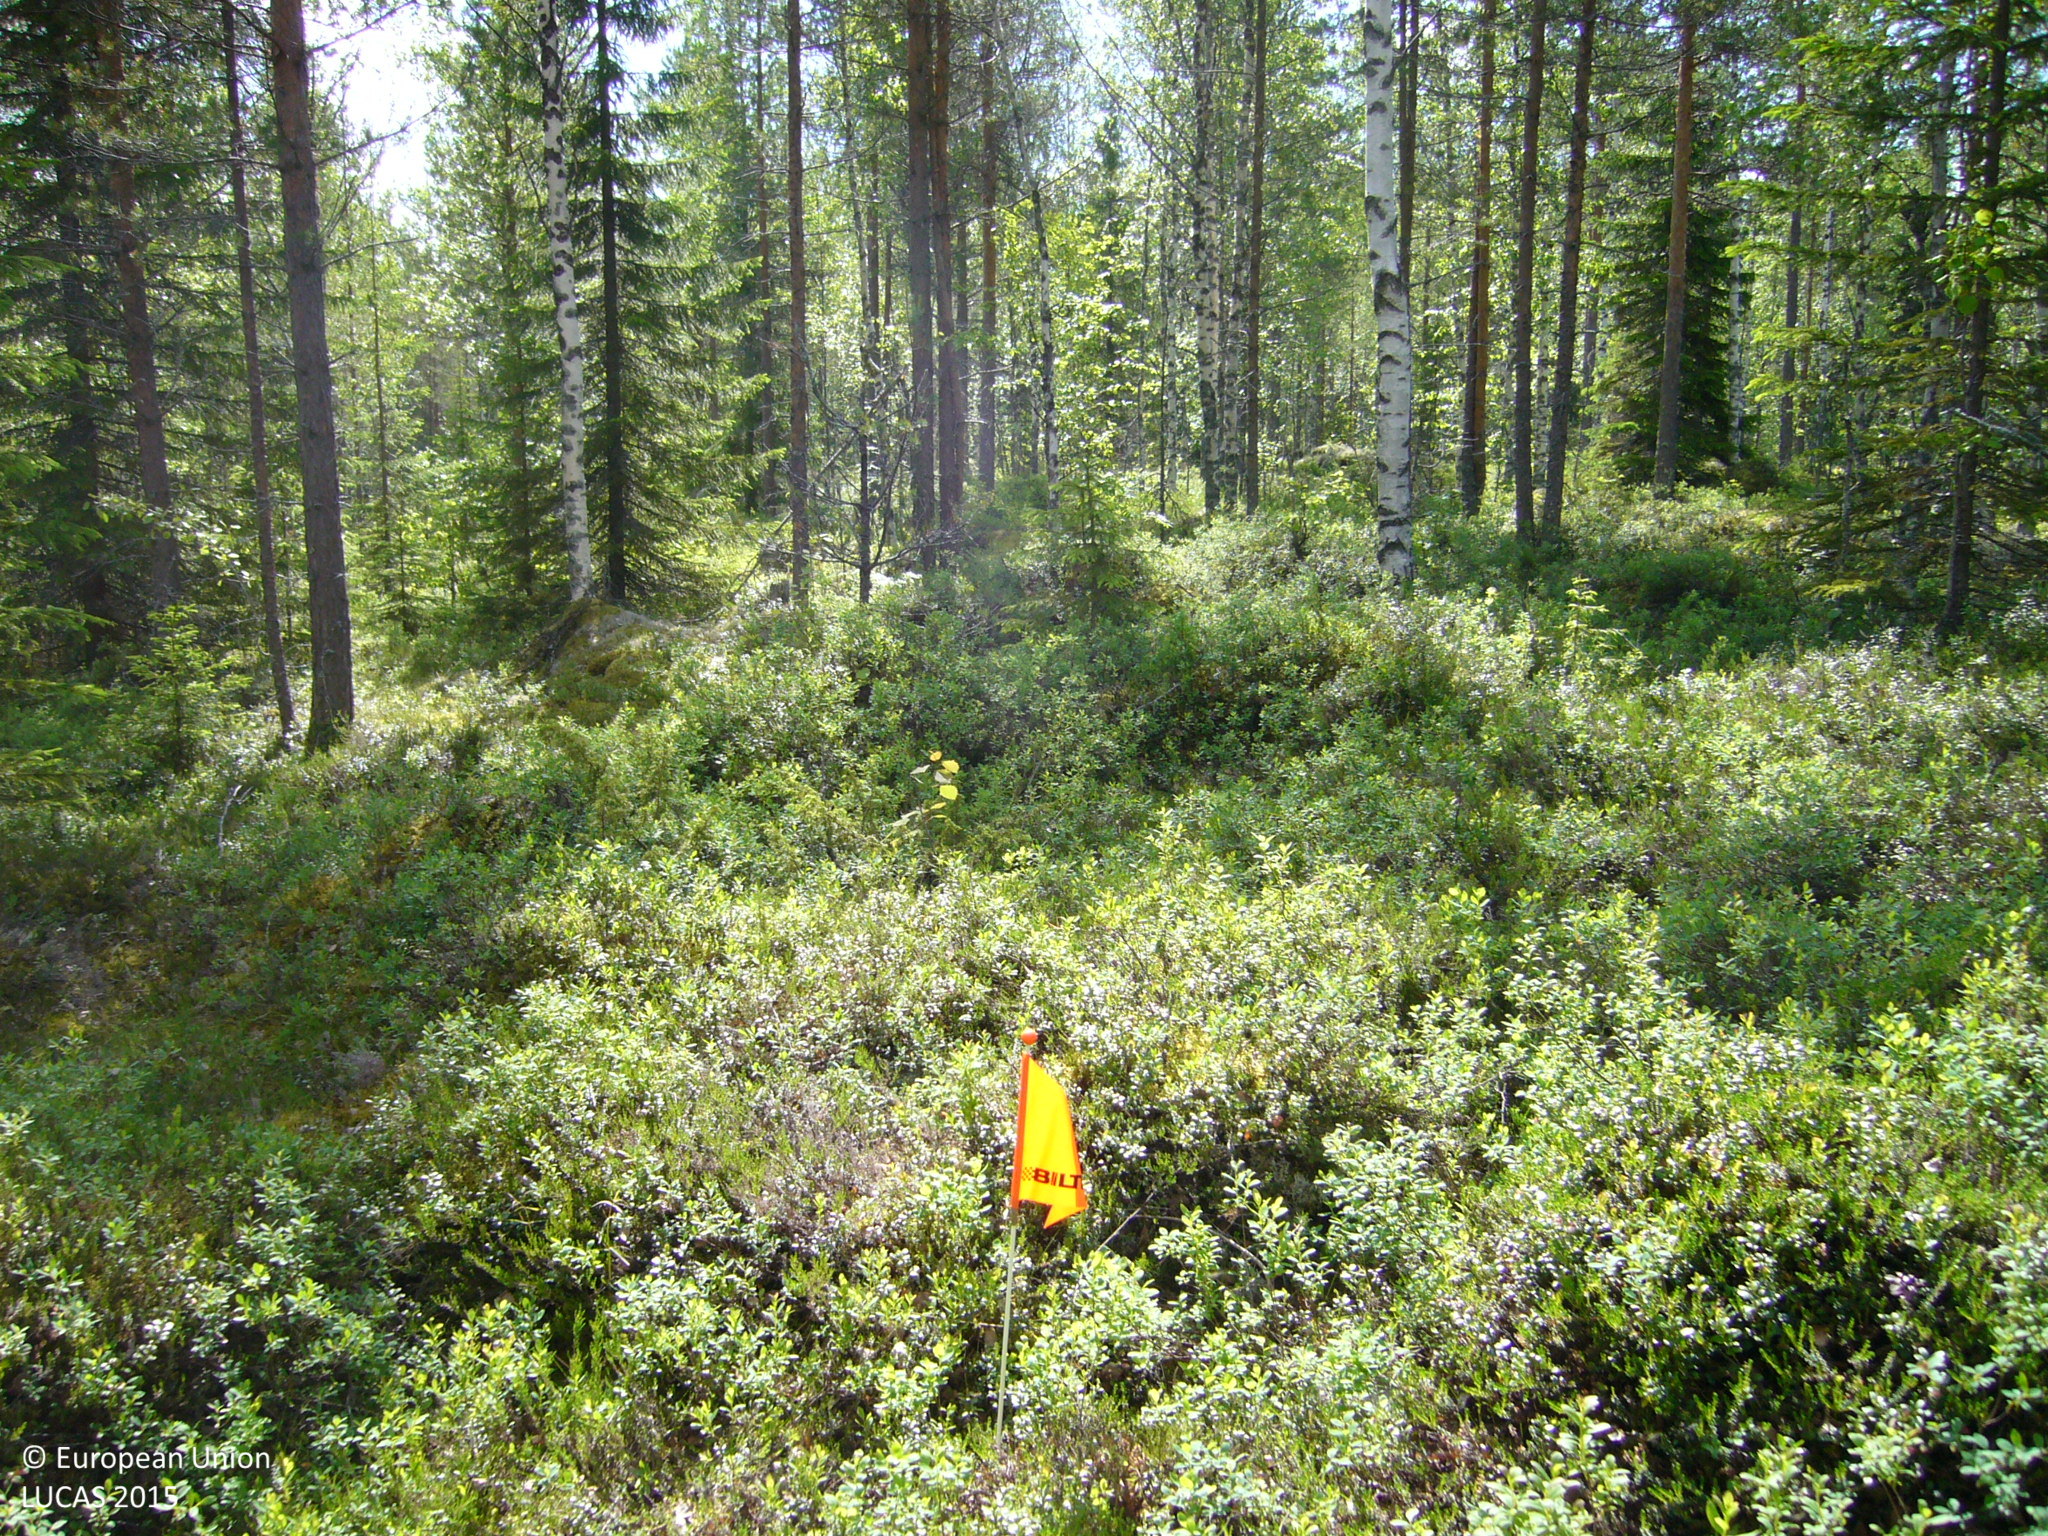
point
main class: Woodland
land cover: Pine dominated mixed woodland
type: boreal forest
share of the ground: 50 - 75 %
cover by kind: coniferous forest trees 45 %, shrubs 30 %, broadleaved forest trees 25 %
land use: Forestry
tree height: > 5 m
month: June
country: FI
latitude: 63.8071
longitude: 26.6355
